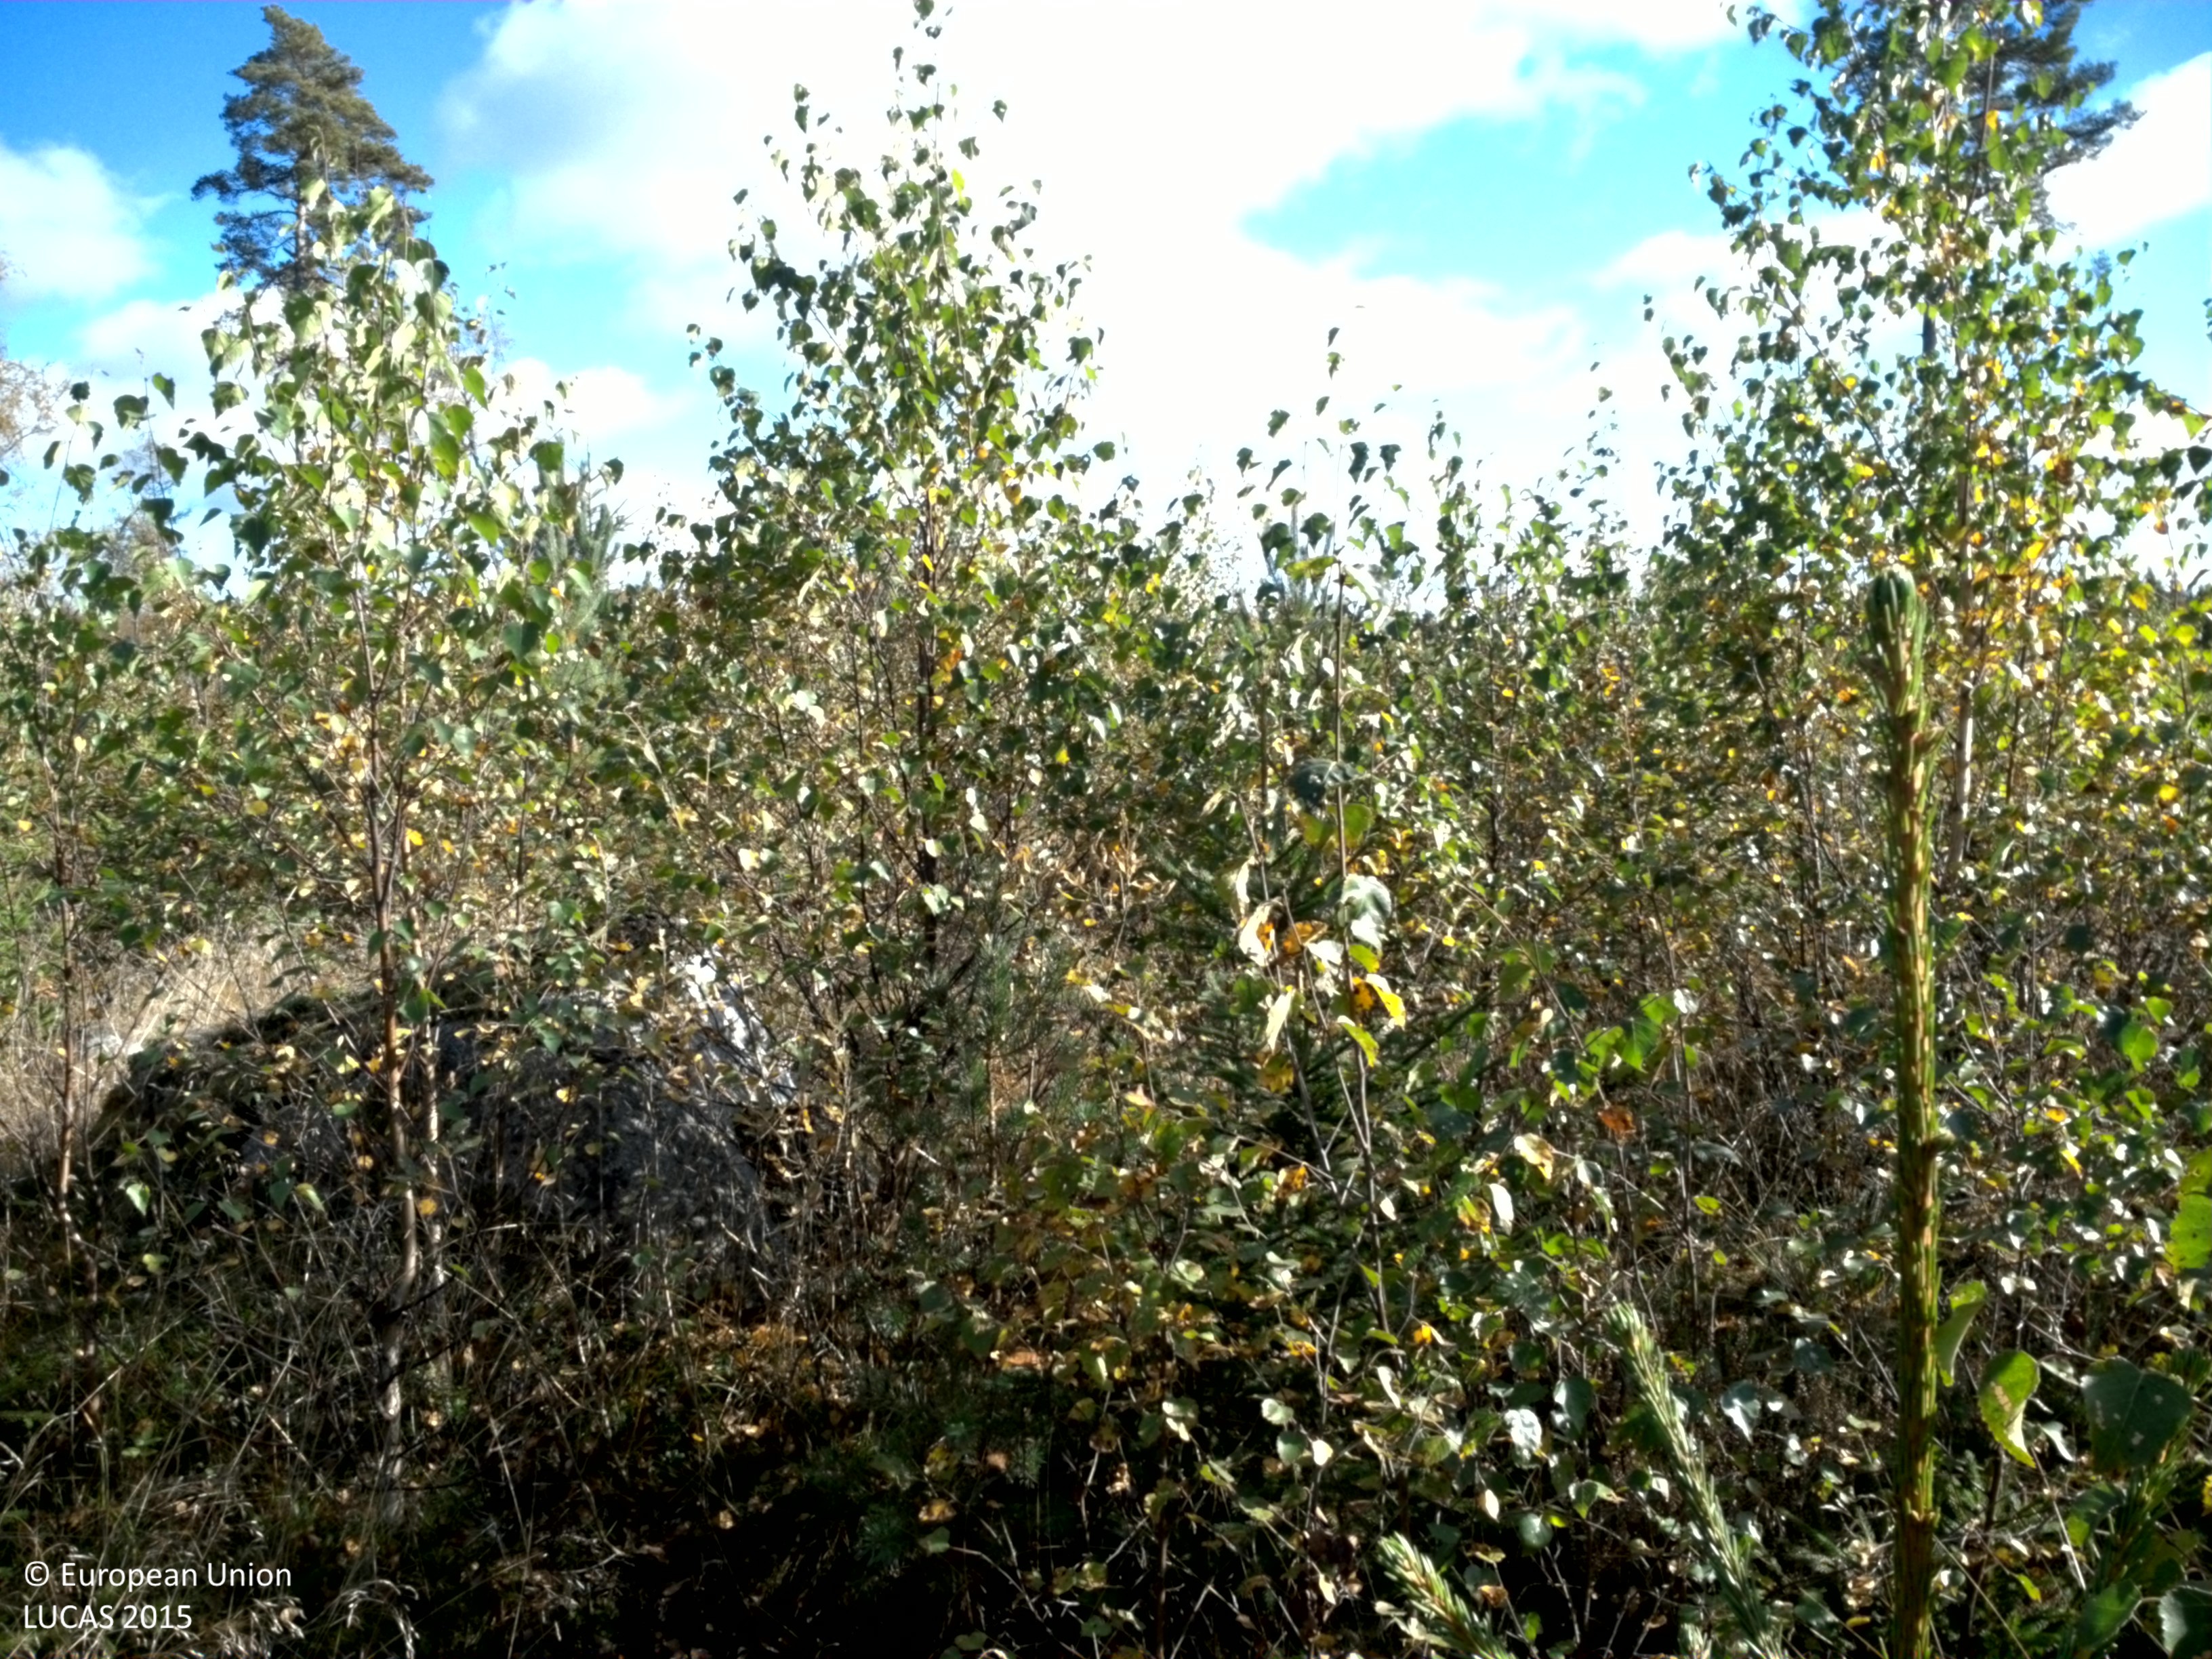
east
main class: Woodland
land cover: Spruce dominated mixed woodland
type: boreal forest
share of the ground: 25 - 50 %
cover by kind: coniferous forest trees 30 %, herbaceous plants 30 %, lichens and mosses 30 %, broadleaved forest trees 10 %
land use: Forestry
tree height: > 5 m
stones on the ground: 10 - 25 %
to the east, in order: Spruce dominated mixed woodland; Broadleaved woodland; Pine dominated mixed woodland; Spruce dominated mixed woodland; Broadleaved woodland; Spruce dominated mixed woodland; Ditches and canals; Spruce dominated mixed woodland; Pine dominated coniferous woodland
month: September
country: SE
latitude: 60.0876
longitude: 16.4441
